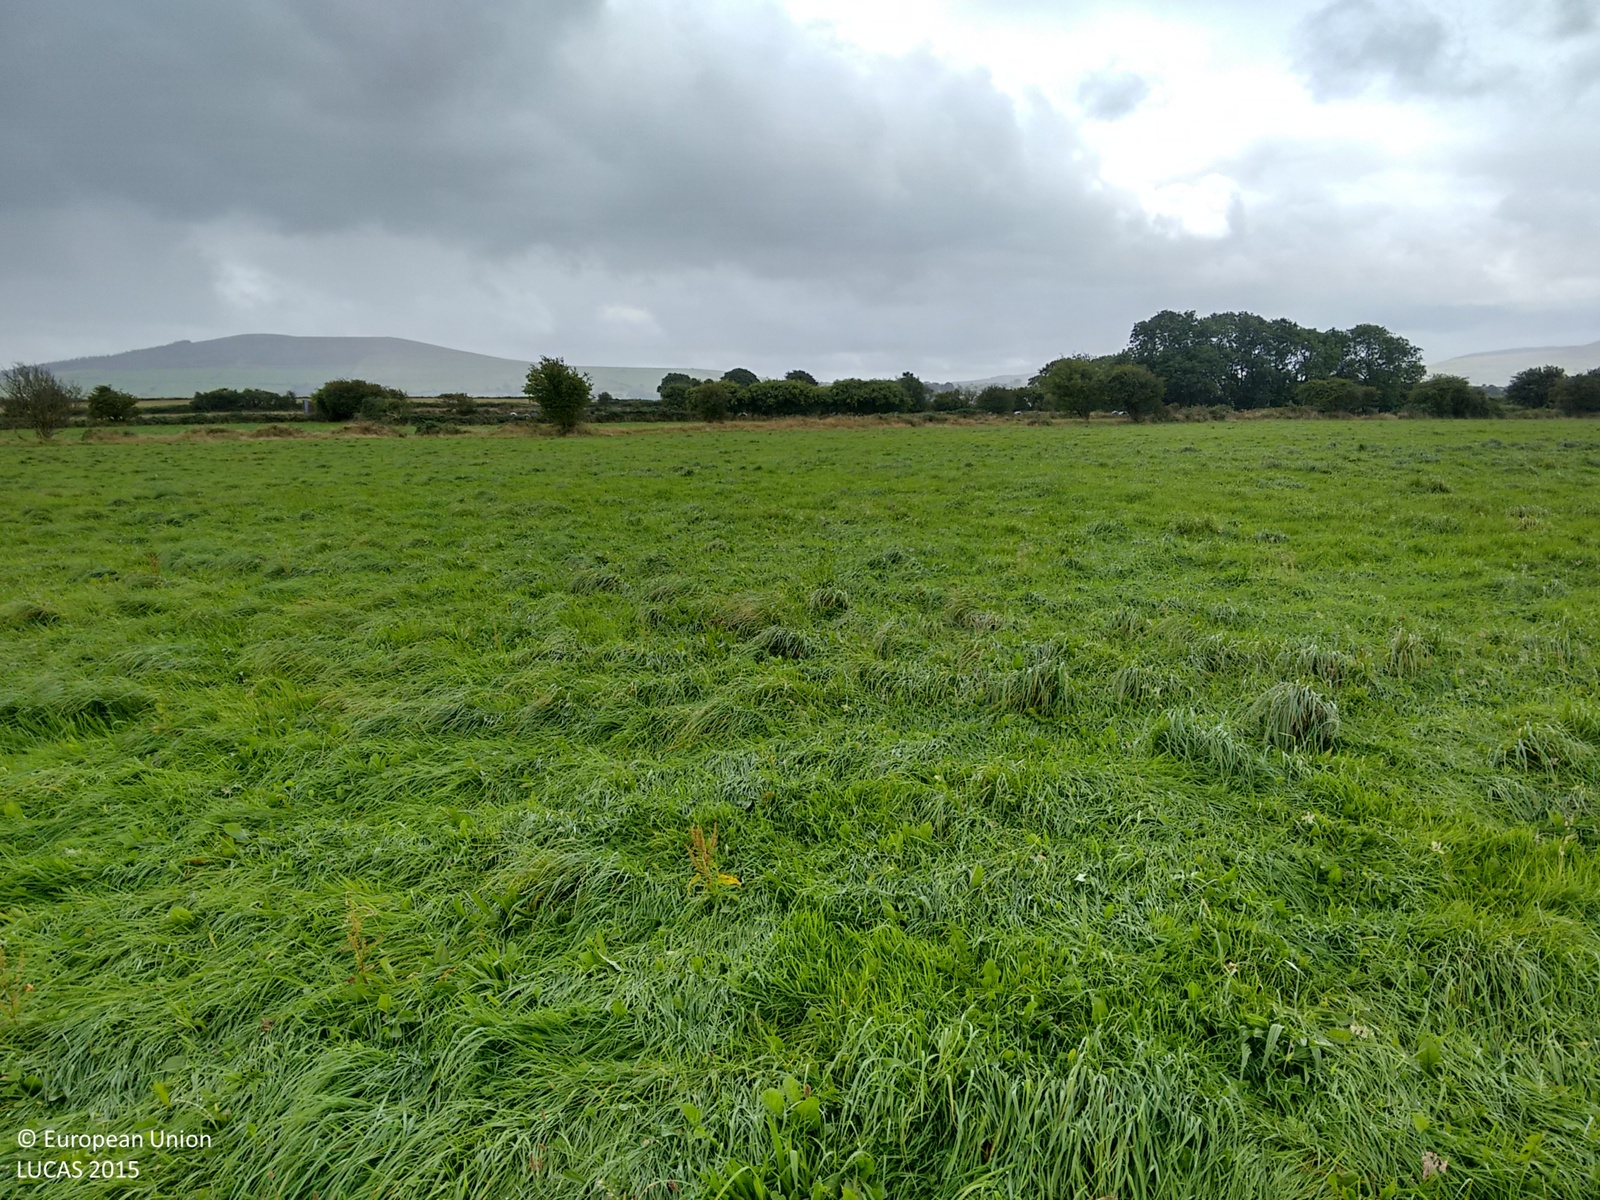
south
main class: Grassland
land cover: Grassland without tree/shrub cover
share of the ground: > 75 %
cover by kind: herbaceous plants 100 %
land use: Agriculture (excluding fallow land and kitchen gardens)
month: August
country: GB
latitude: 52.0123
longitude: -4.6347
